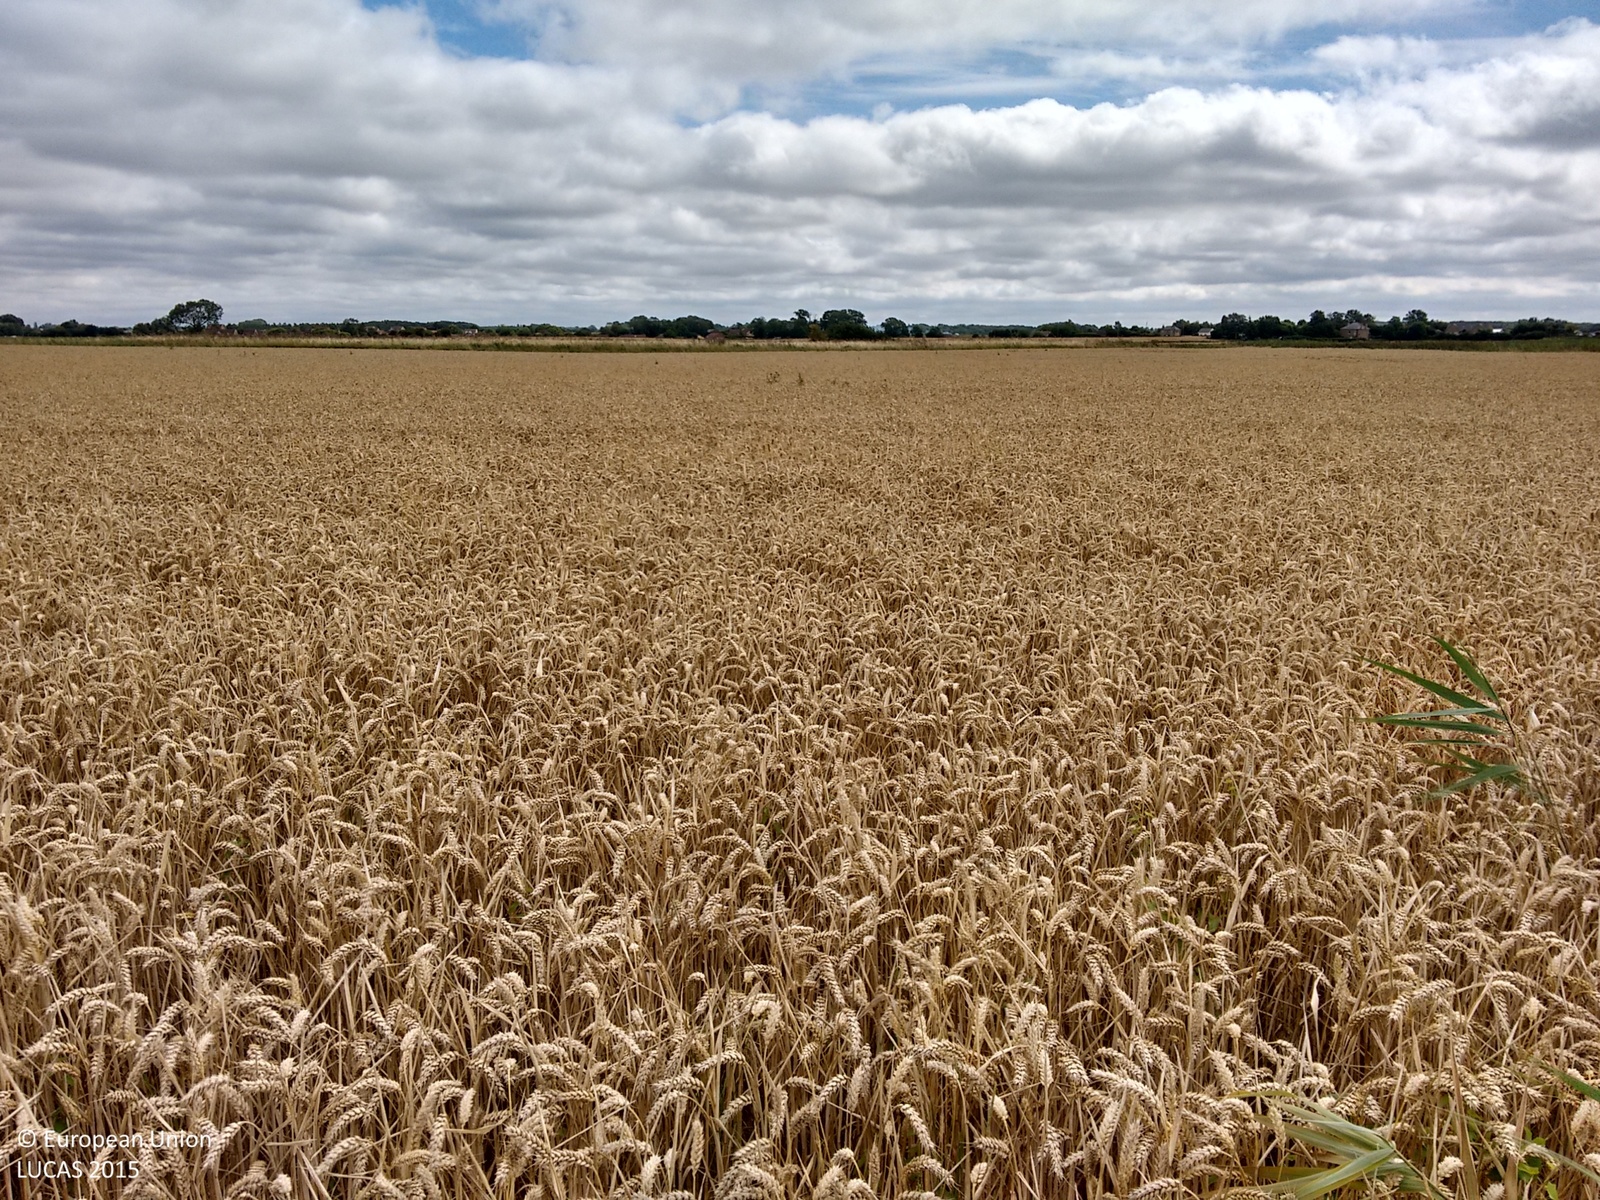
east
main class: Cropland
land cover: Common wheat
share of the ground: > 75 %
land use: Agriculture (excluding fallow land and kitchen gardens)
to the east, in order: Common wheat; Grass margins; Ditches and canals; Spontaneously vegetated surfaces; Ditches and canals; Grass margins; Dry pulses; Grass margins; Tracks; Grass margins; Ditches and canals; Grass margins; Sugar beet
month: August
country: GB
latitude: 52.6356
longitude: 0.3517
